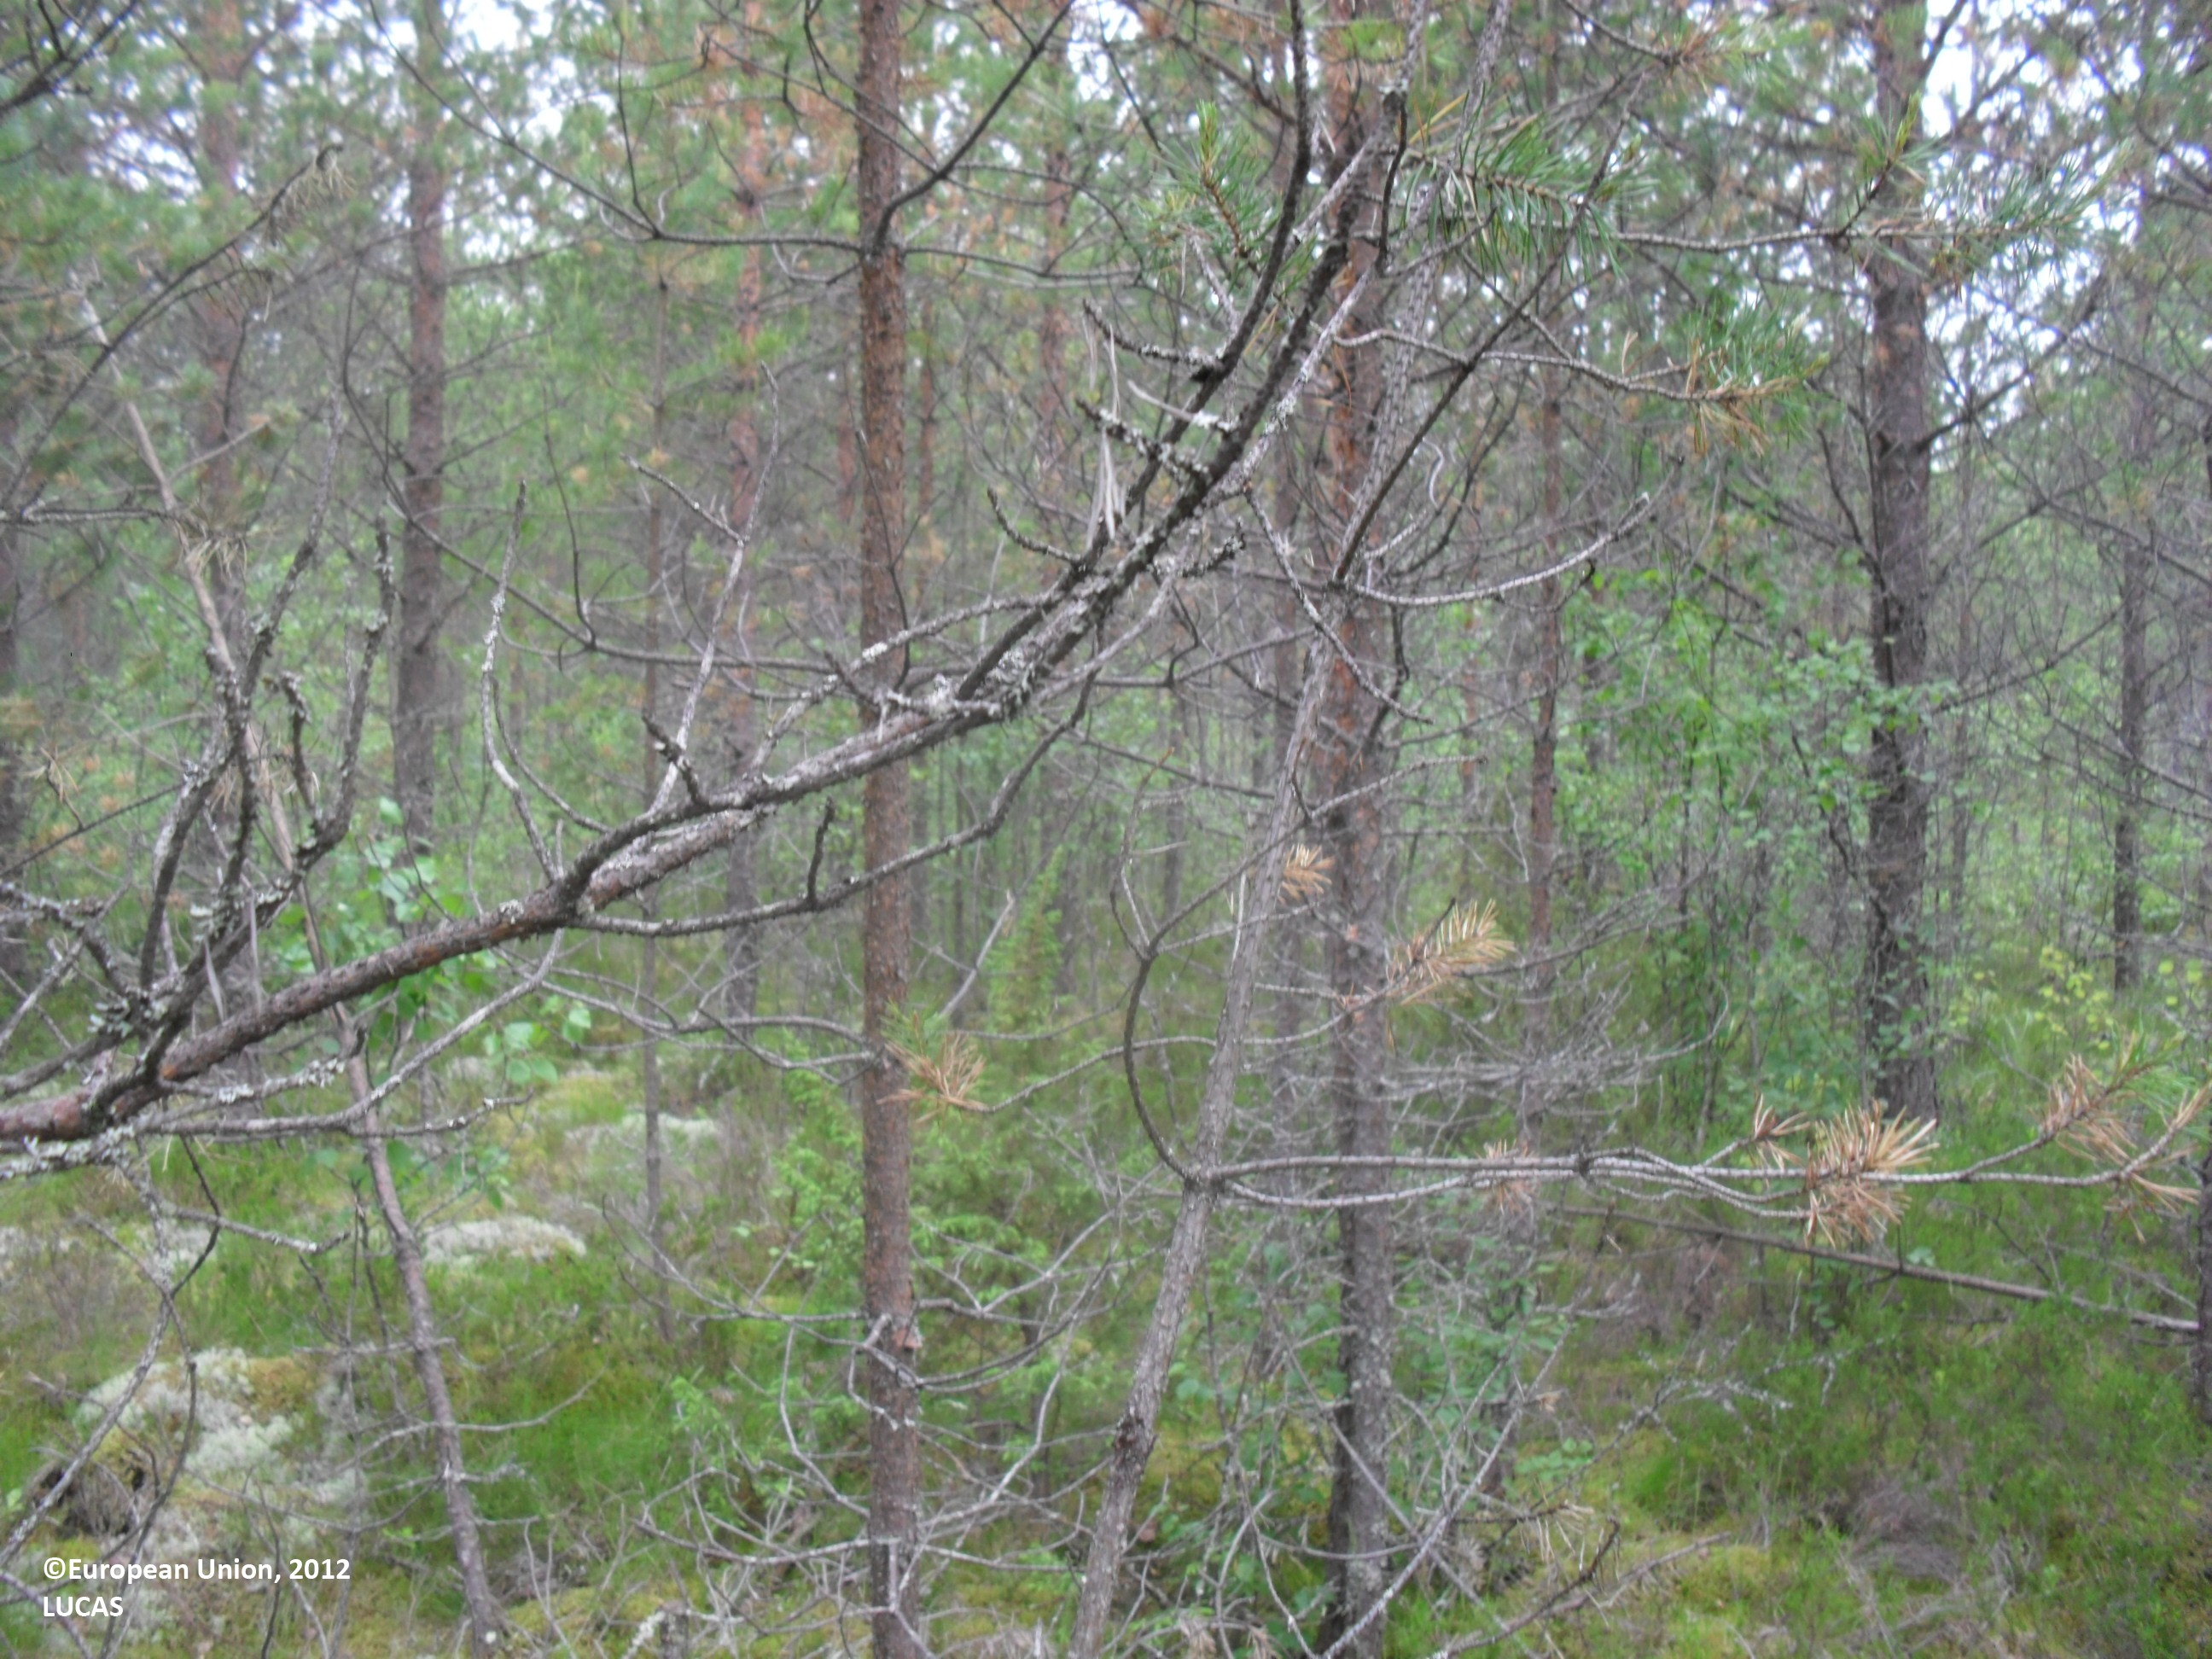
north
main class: Woodland
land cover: Pine dominated coniferous woodland
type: boreal forest
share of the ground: 50 - 75 %
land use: Forestry
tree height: > 5 m
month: June
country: FI
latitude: 62.9099
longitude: 23.5913
